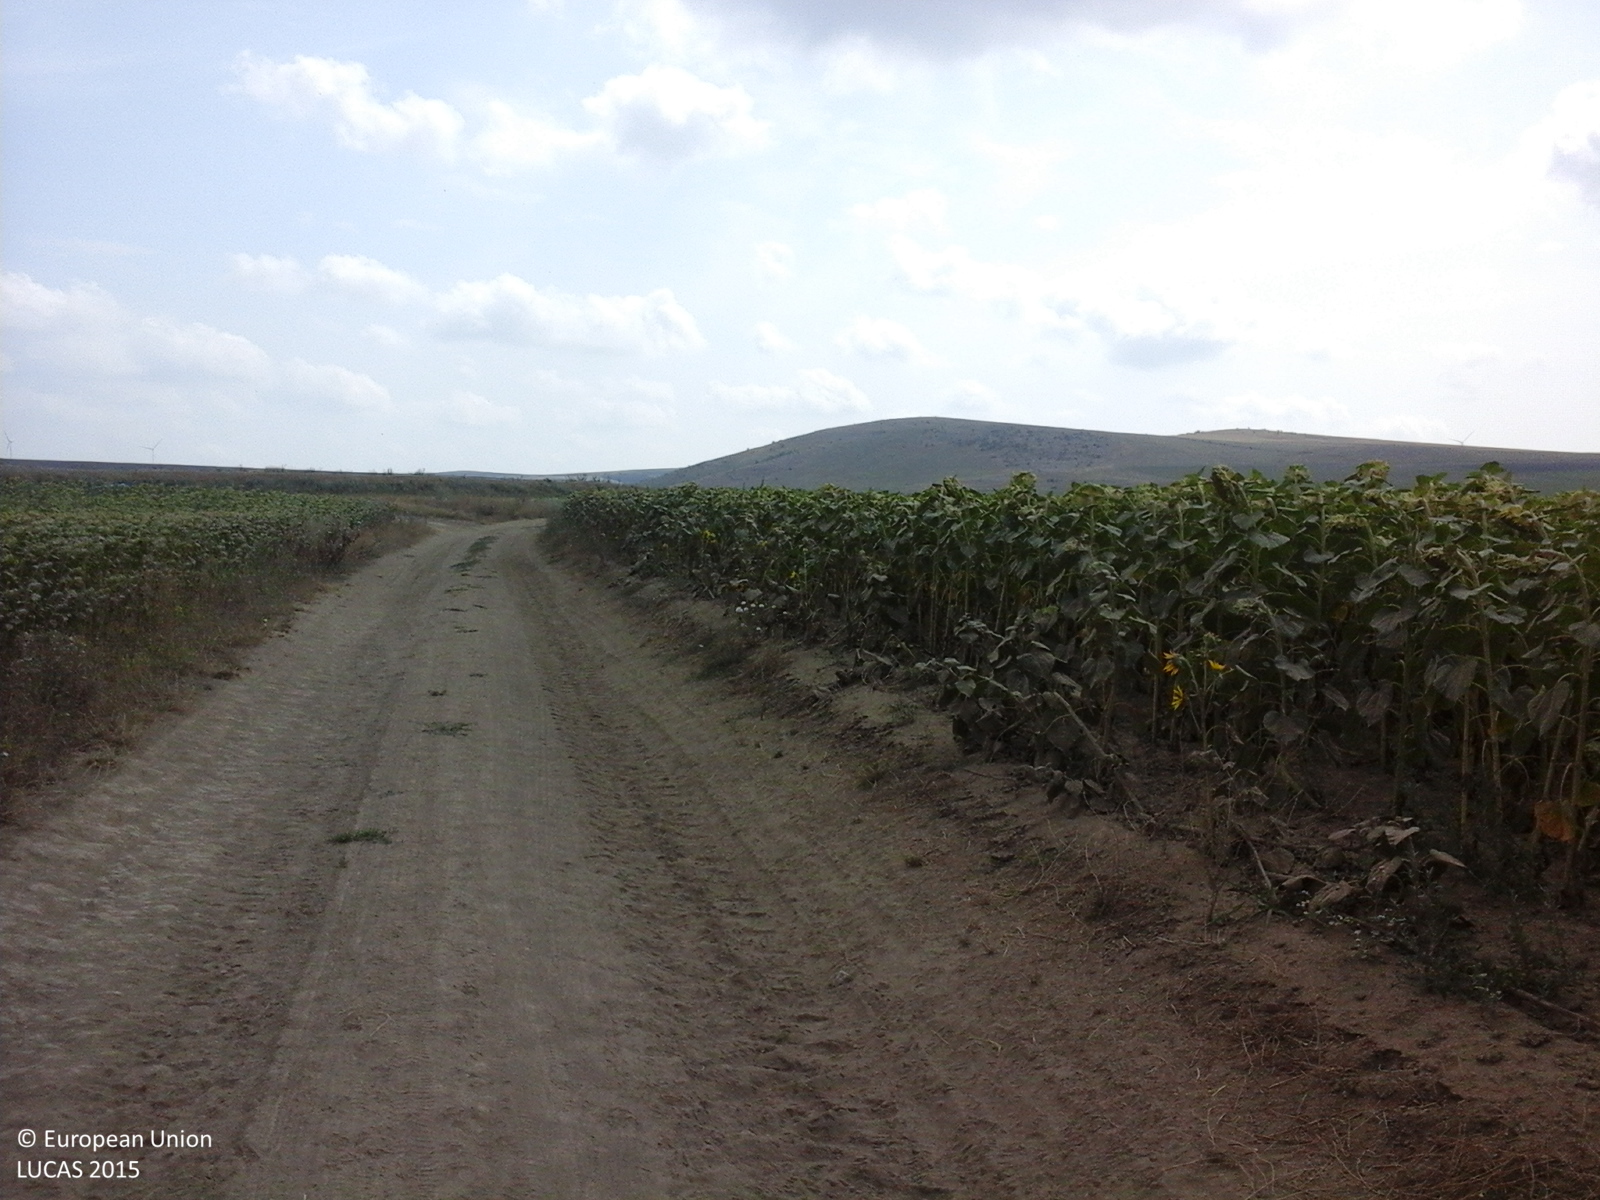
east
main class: Cropland
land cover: Sunflower
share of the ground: > 75 %
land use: Agriculture (excluding fallow land and kitchen gardens)
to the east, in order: Sunflower; Other bare soil
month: July
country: RO
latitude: 45.0410
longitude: 28.7615
